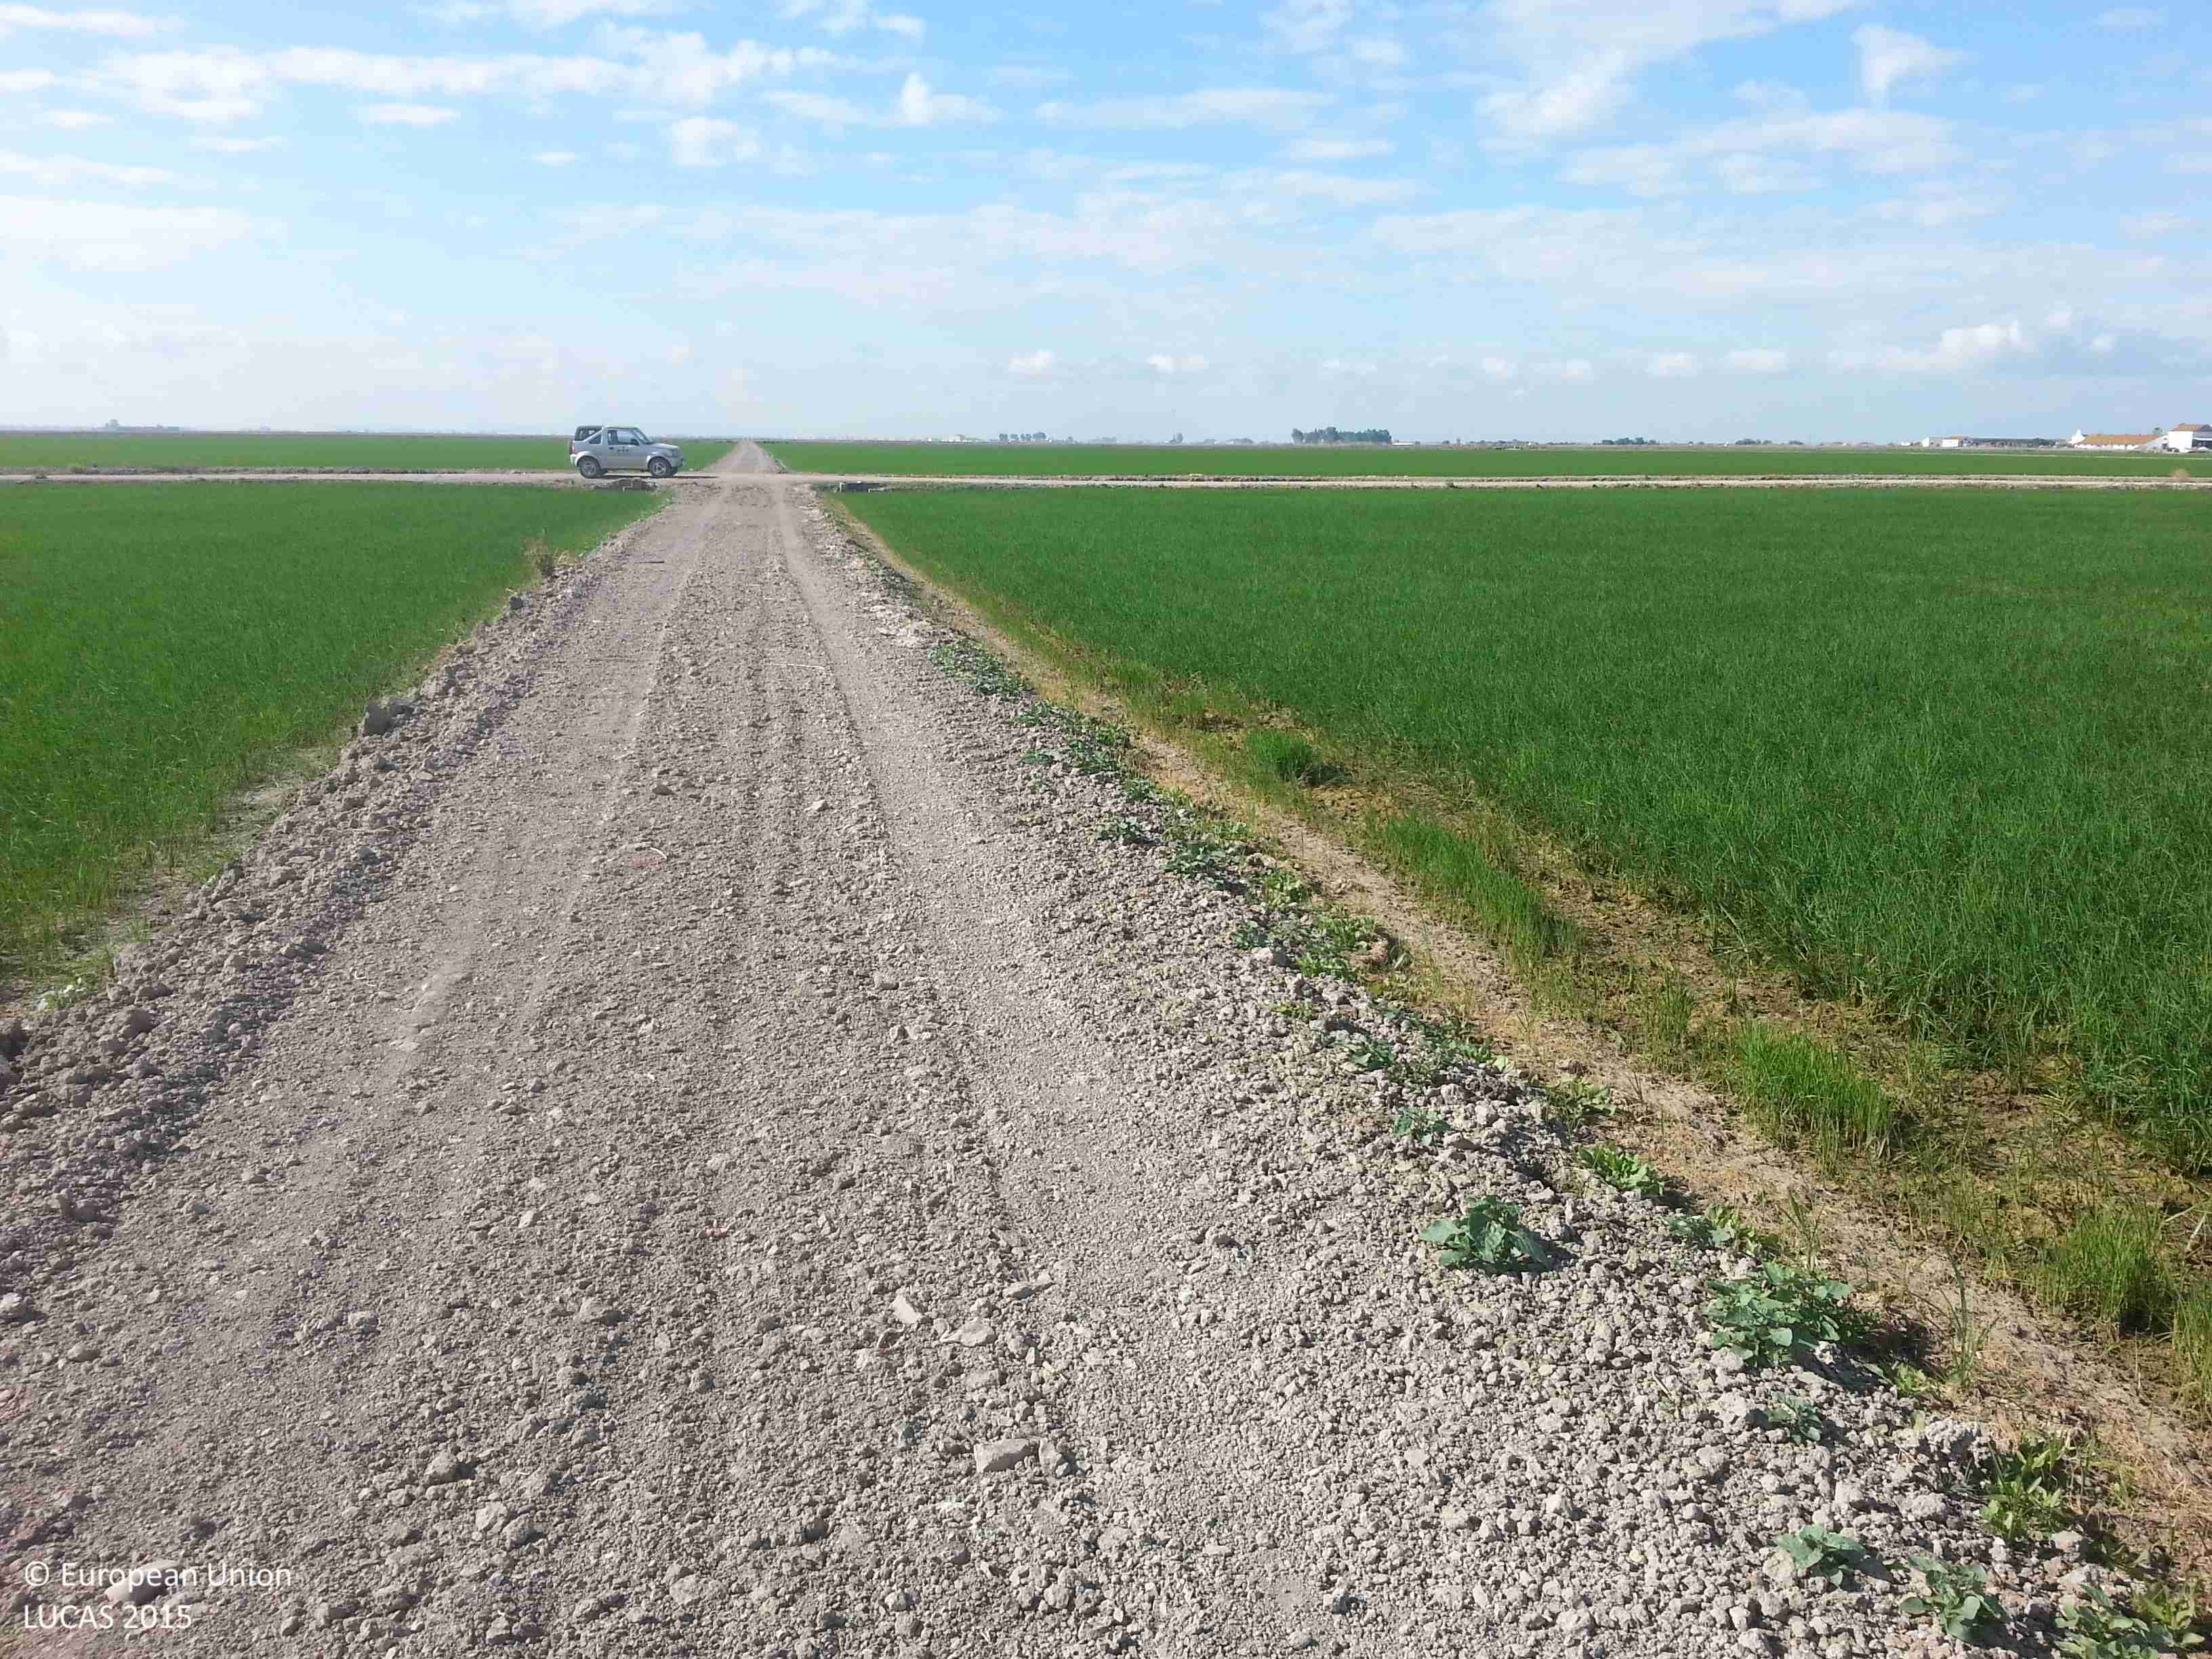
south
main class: Cropland
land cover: Rice
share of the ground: > 75 %
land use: Agriculture (excluding fallow land and kitchen gardens)
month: June
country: ES
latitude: 37.1430
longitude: -6.0859
